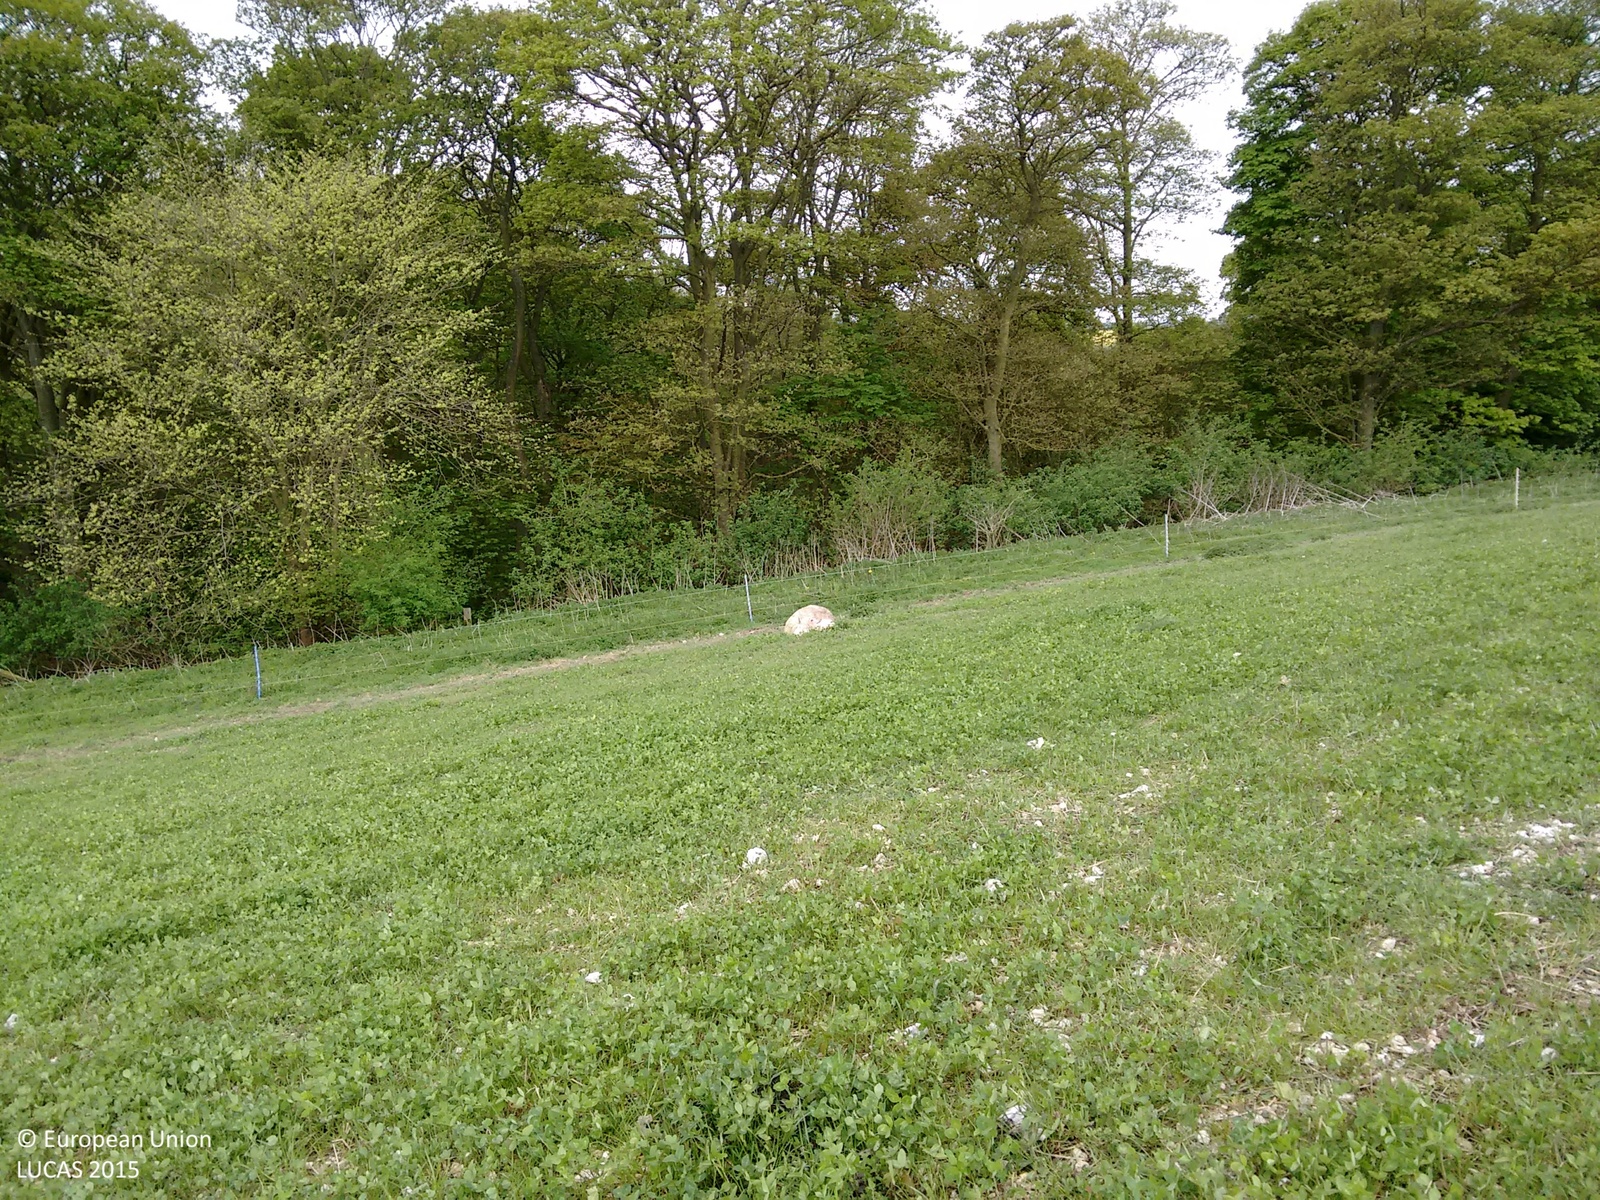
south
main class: Cropland
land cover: Clovers
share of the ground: > 75 %
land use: Agriculture (excluding fallow land and kitchen gardens)
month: May
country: GB
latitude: 53.3224
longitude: -0.1066
